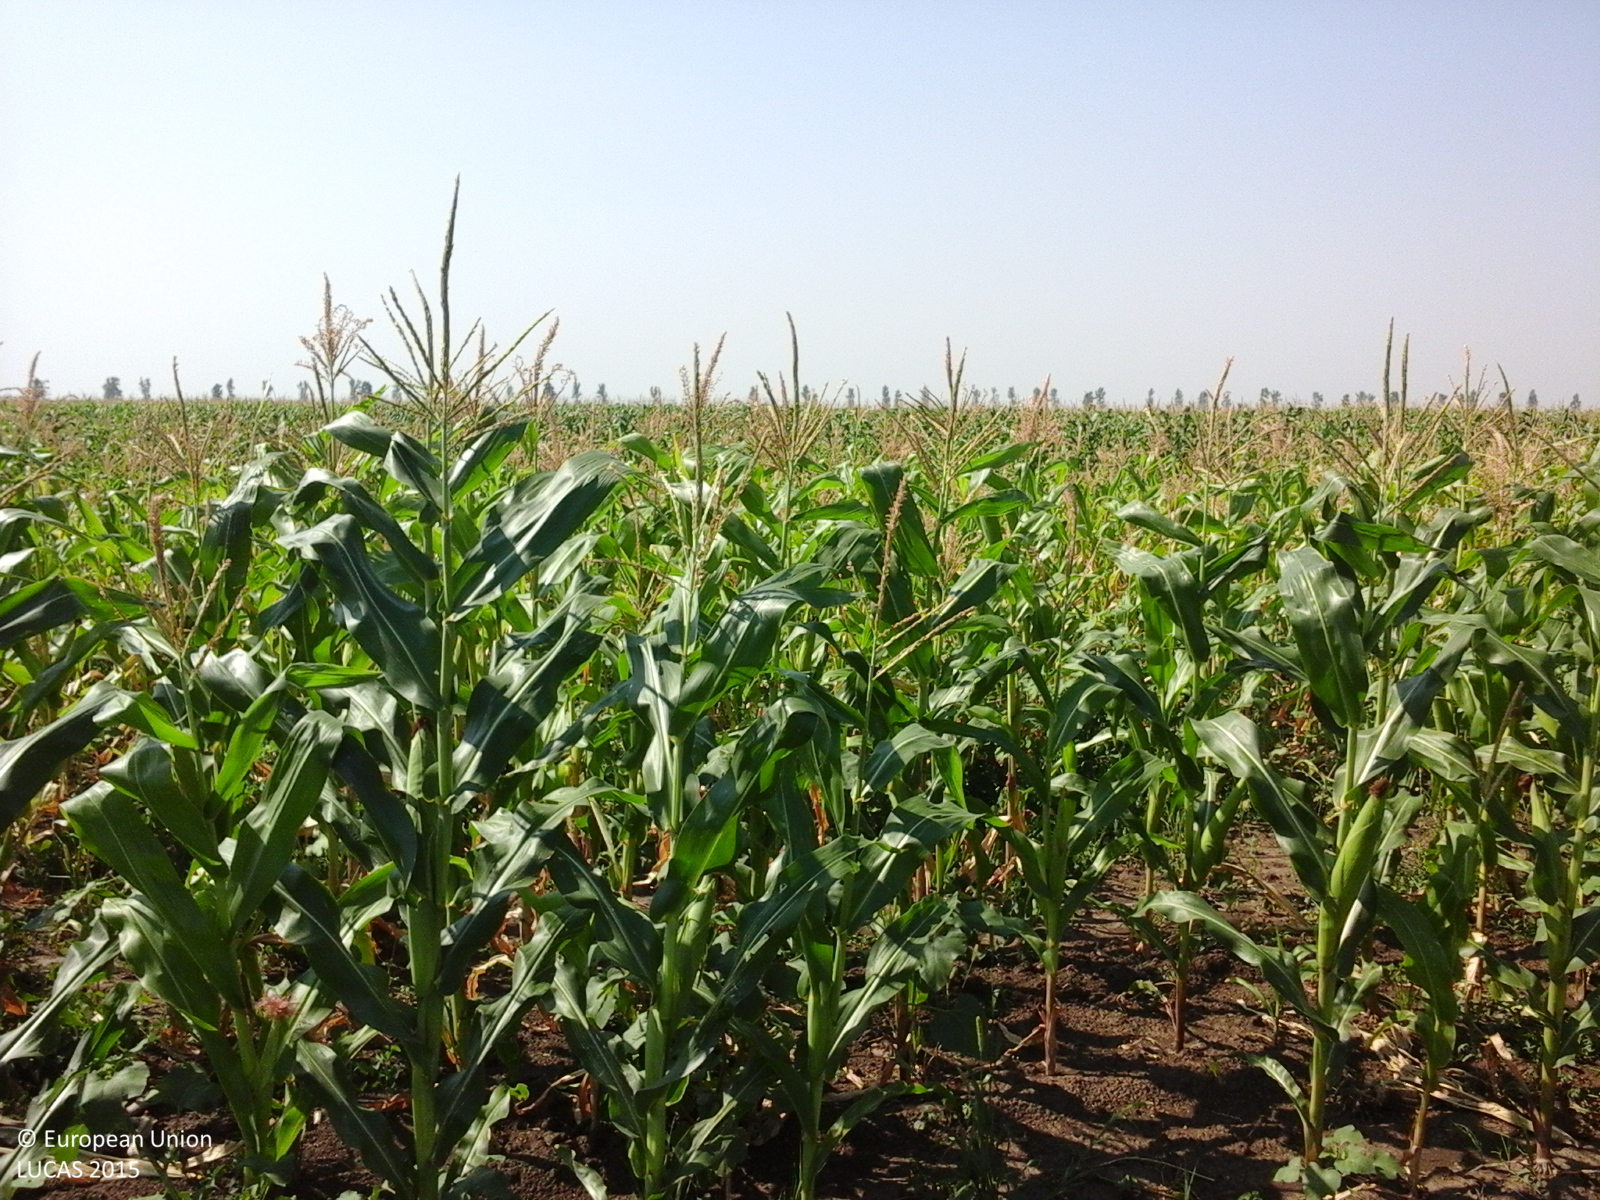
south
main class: Cropland
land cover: Maize
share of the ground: > 75 %
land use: Agriculture (excluding fallow land and kitchen gardens)
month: August
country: RO
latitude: 45.8430
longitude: 27.6603
